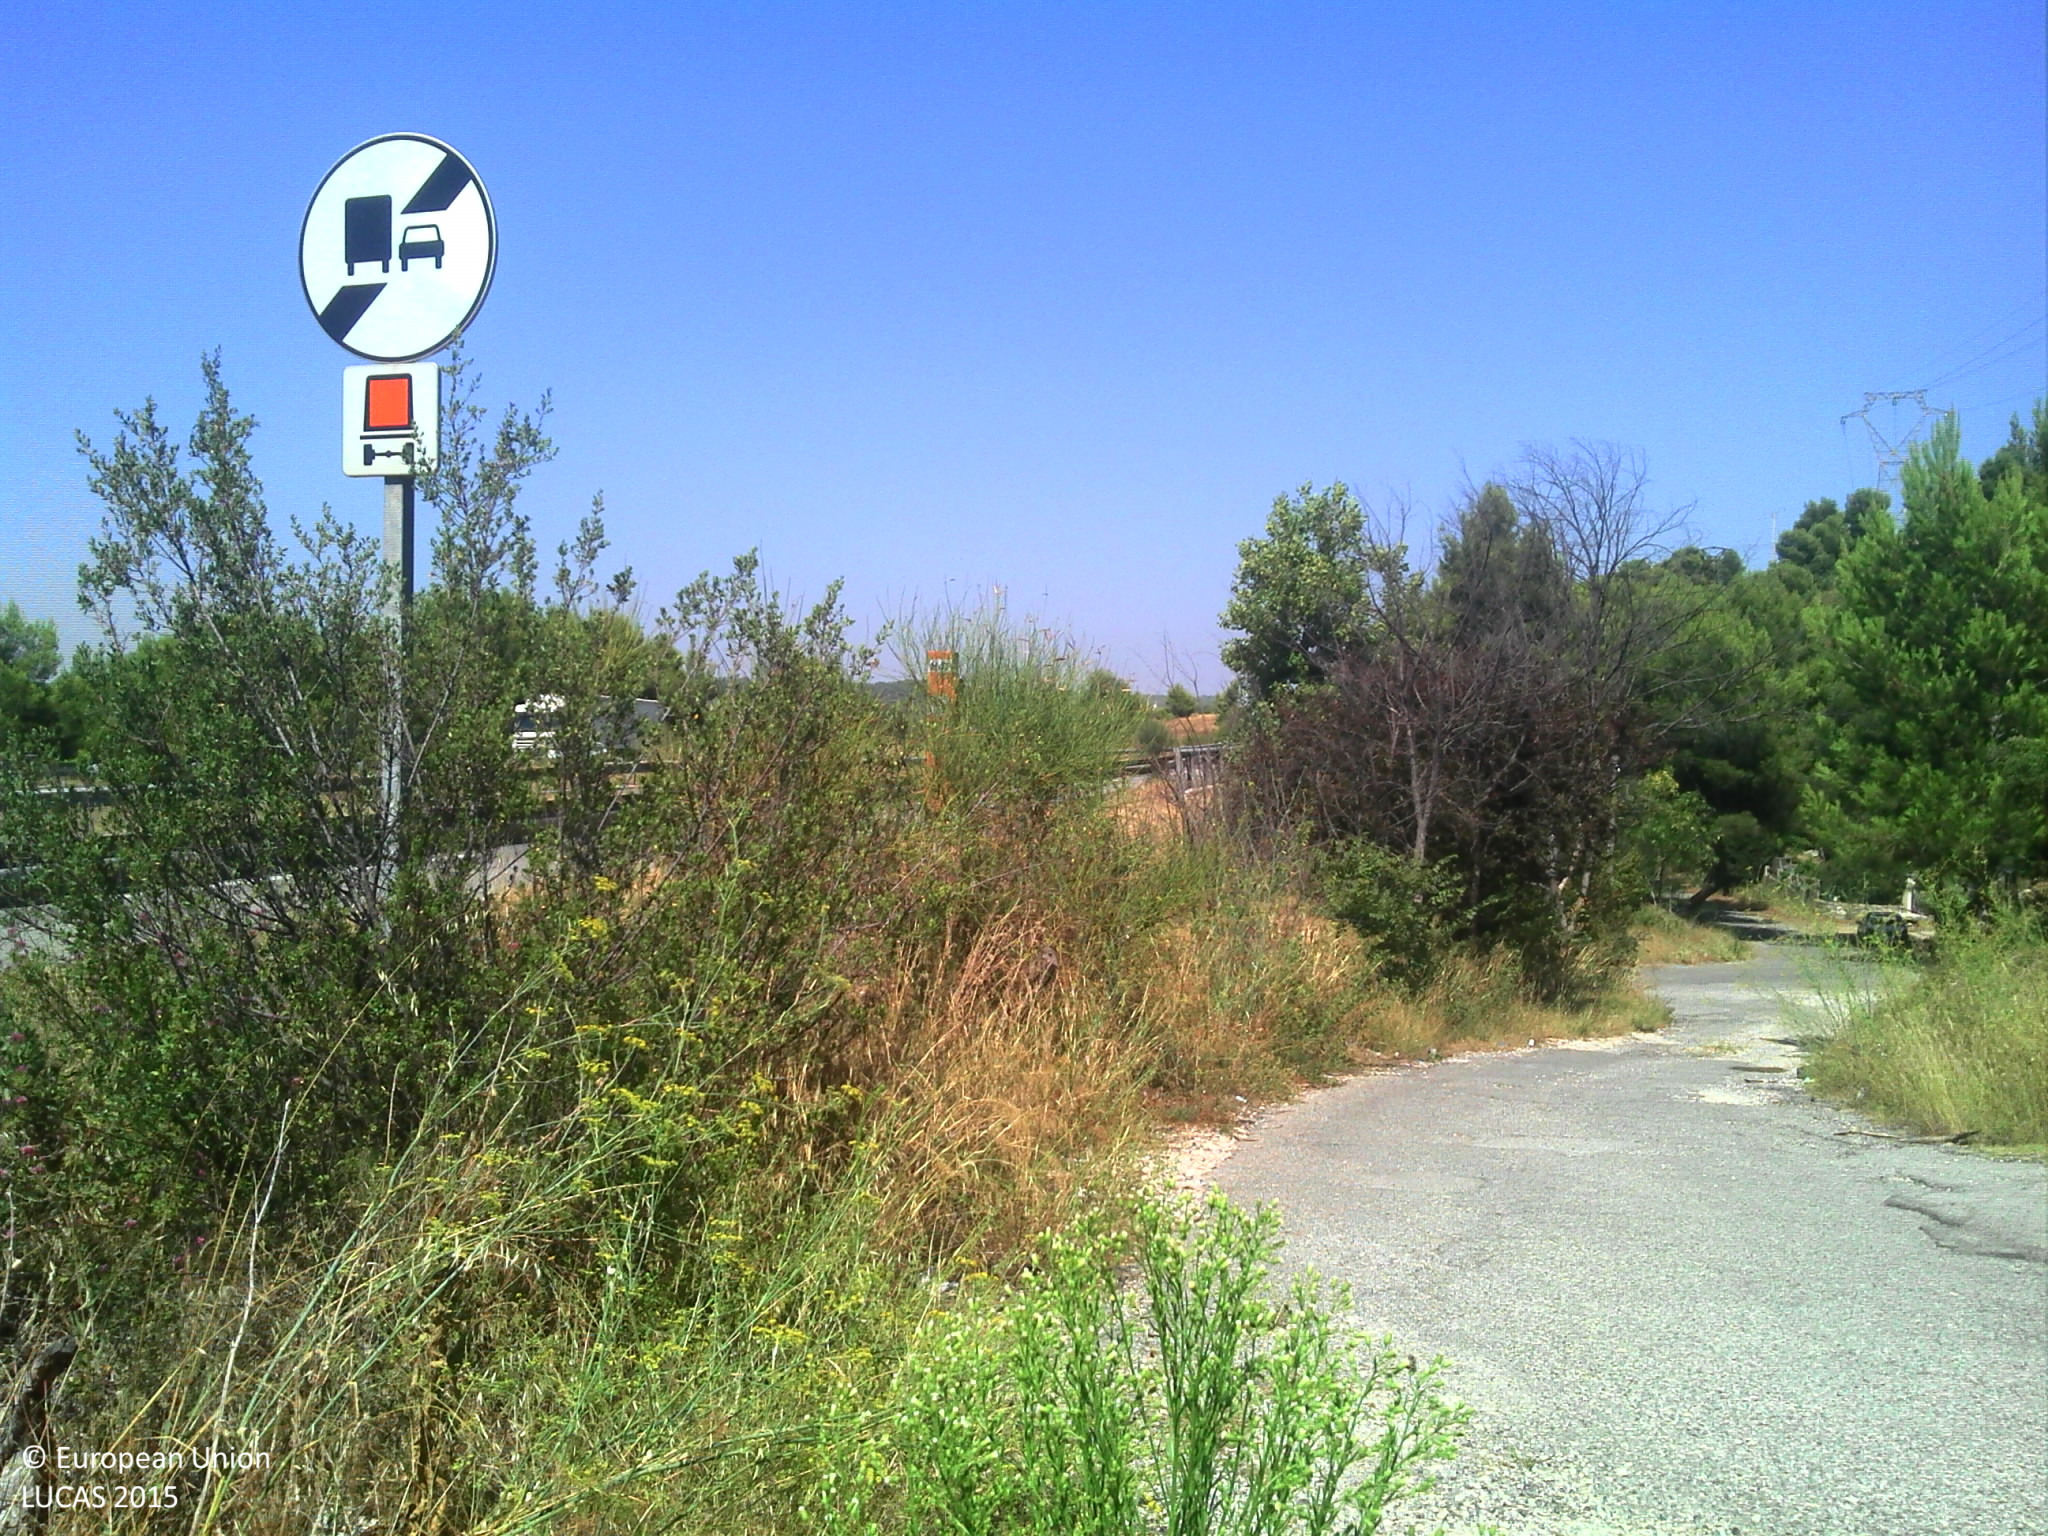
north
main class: Grassland
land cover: Grassland with sparse tree/shrub cover
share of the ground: > 75 %
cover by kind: herbaceous plants 85 %, coniferous forest trees 5 %, consolidated bare surface 5 %
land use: Residential
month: August
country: FR
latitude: 43.3940
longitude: 5.2817
